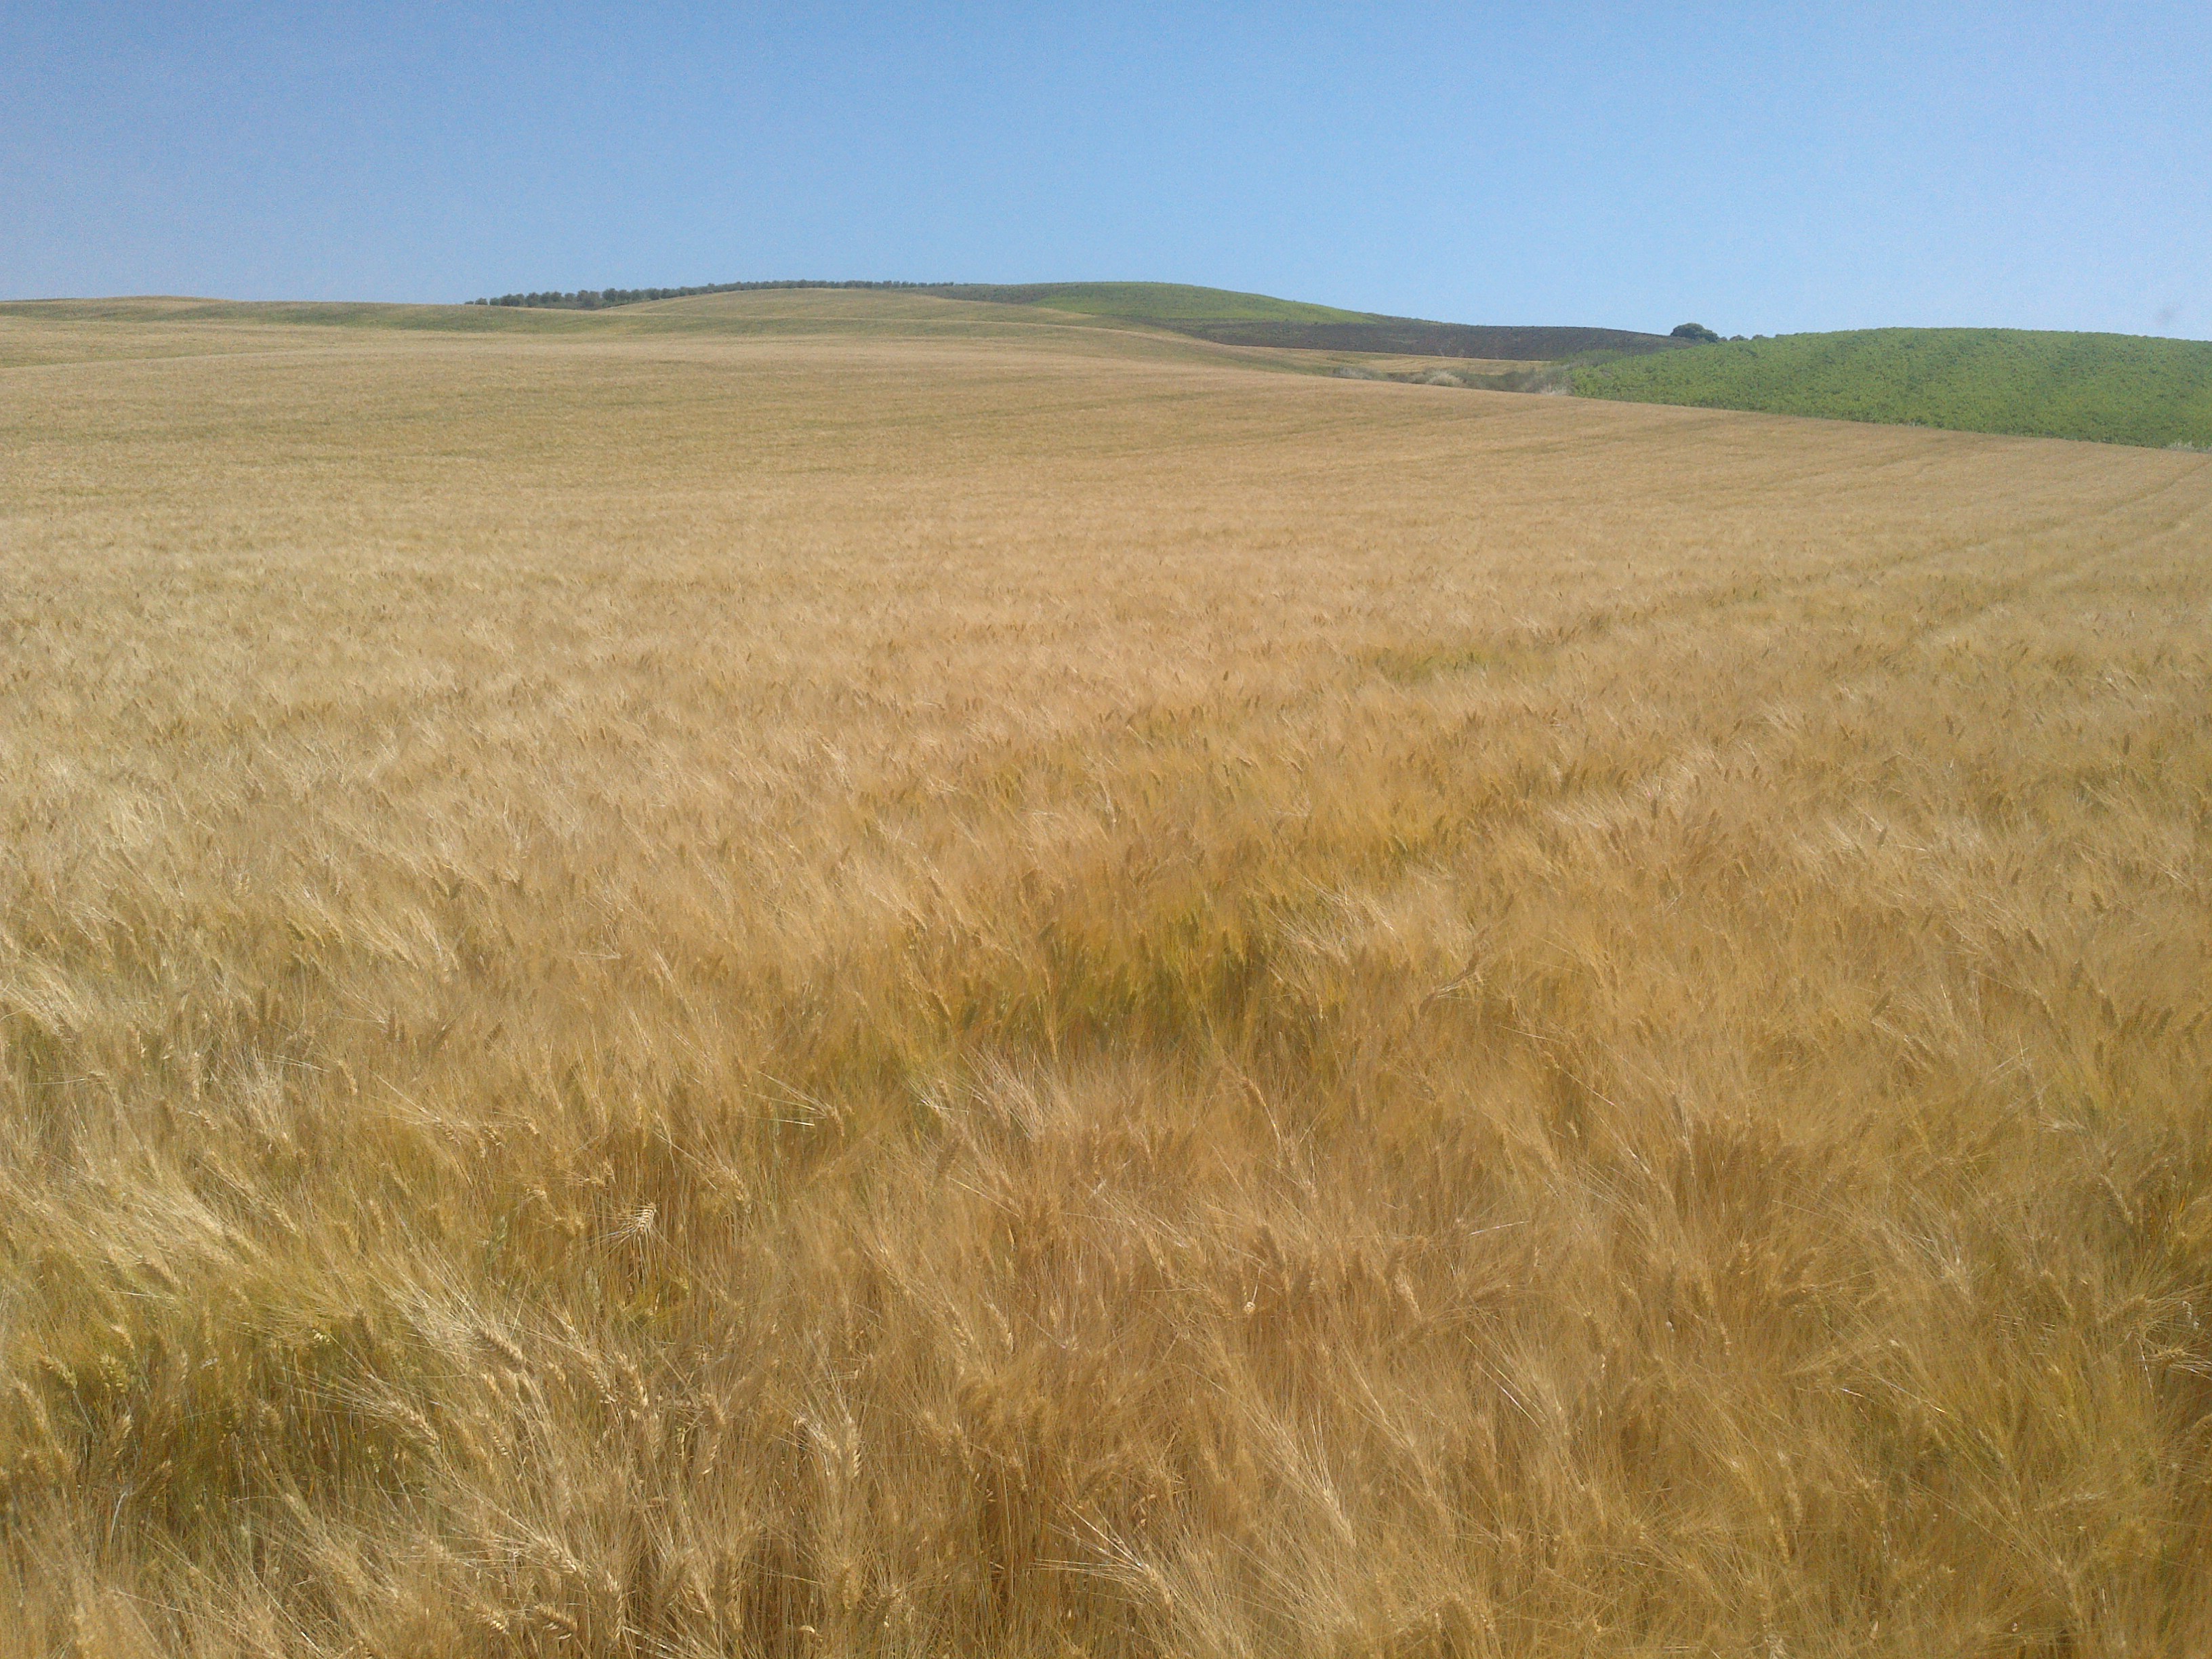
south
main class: Cropland
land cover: Durum wheat
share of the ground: > 75 %
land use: Agriculture (excluding fallow land and kitchen gardens)
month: May
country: ES
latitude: 37.8761
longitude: -4.6441
